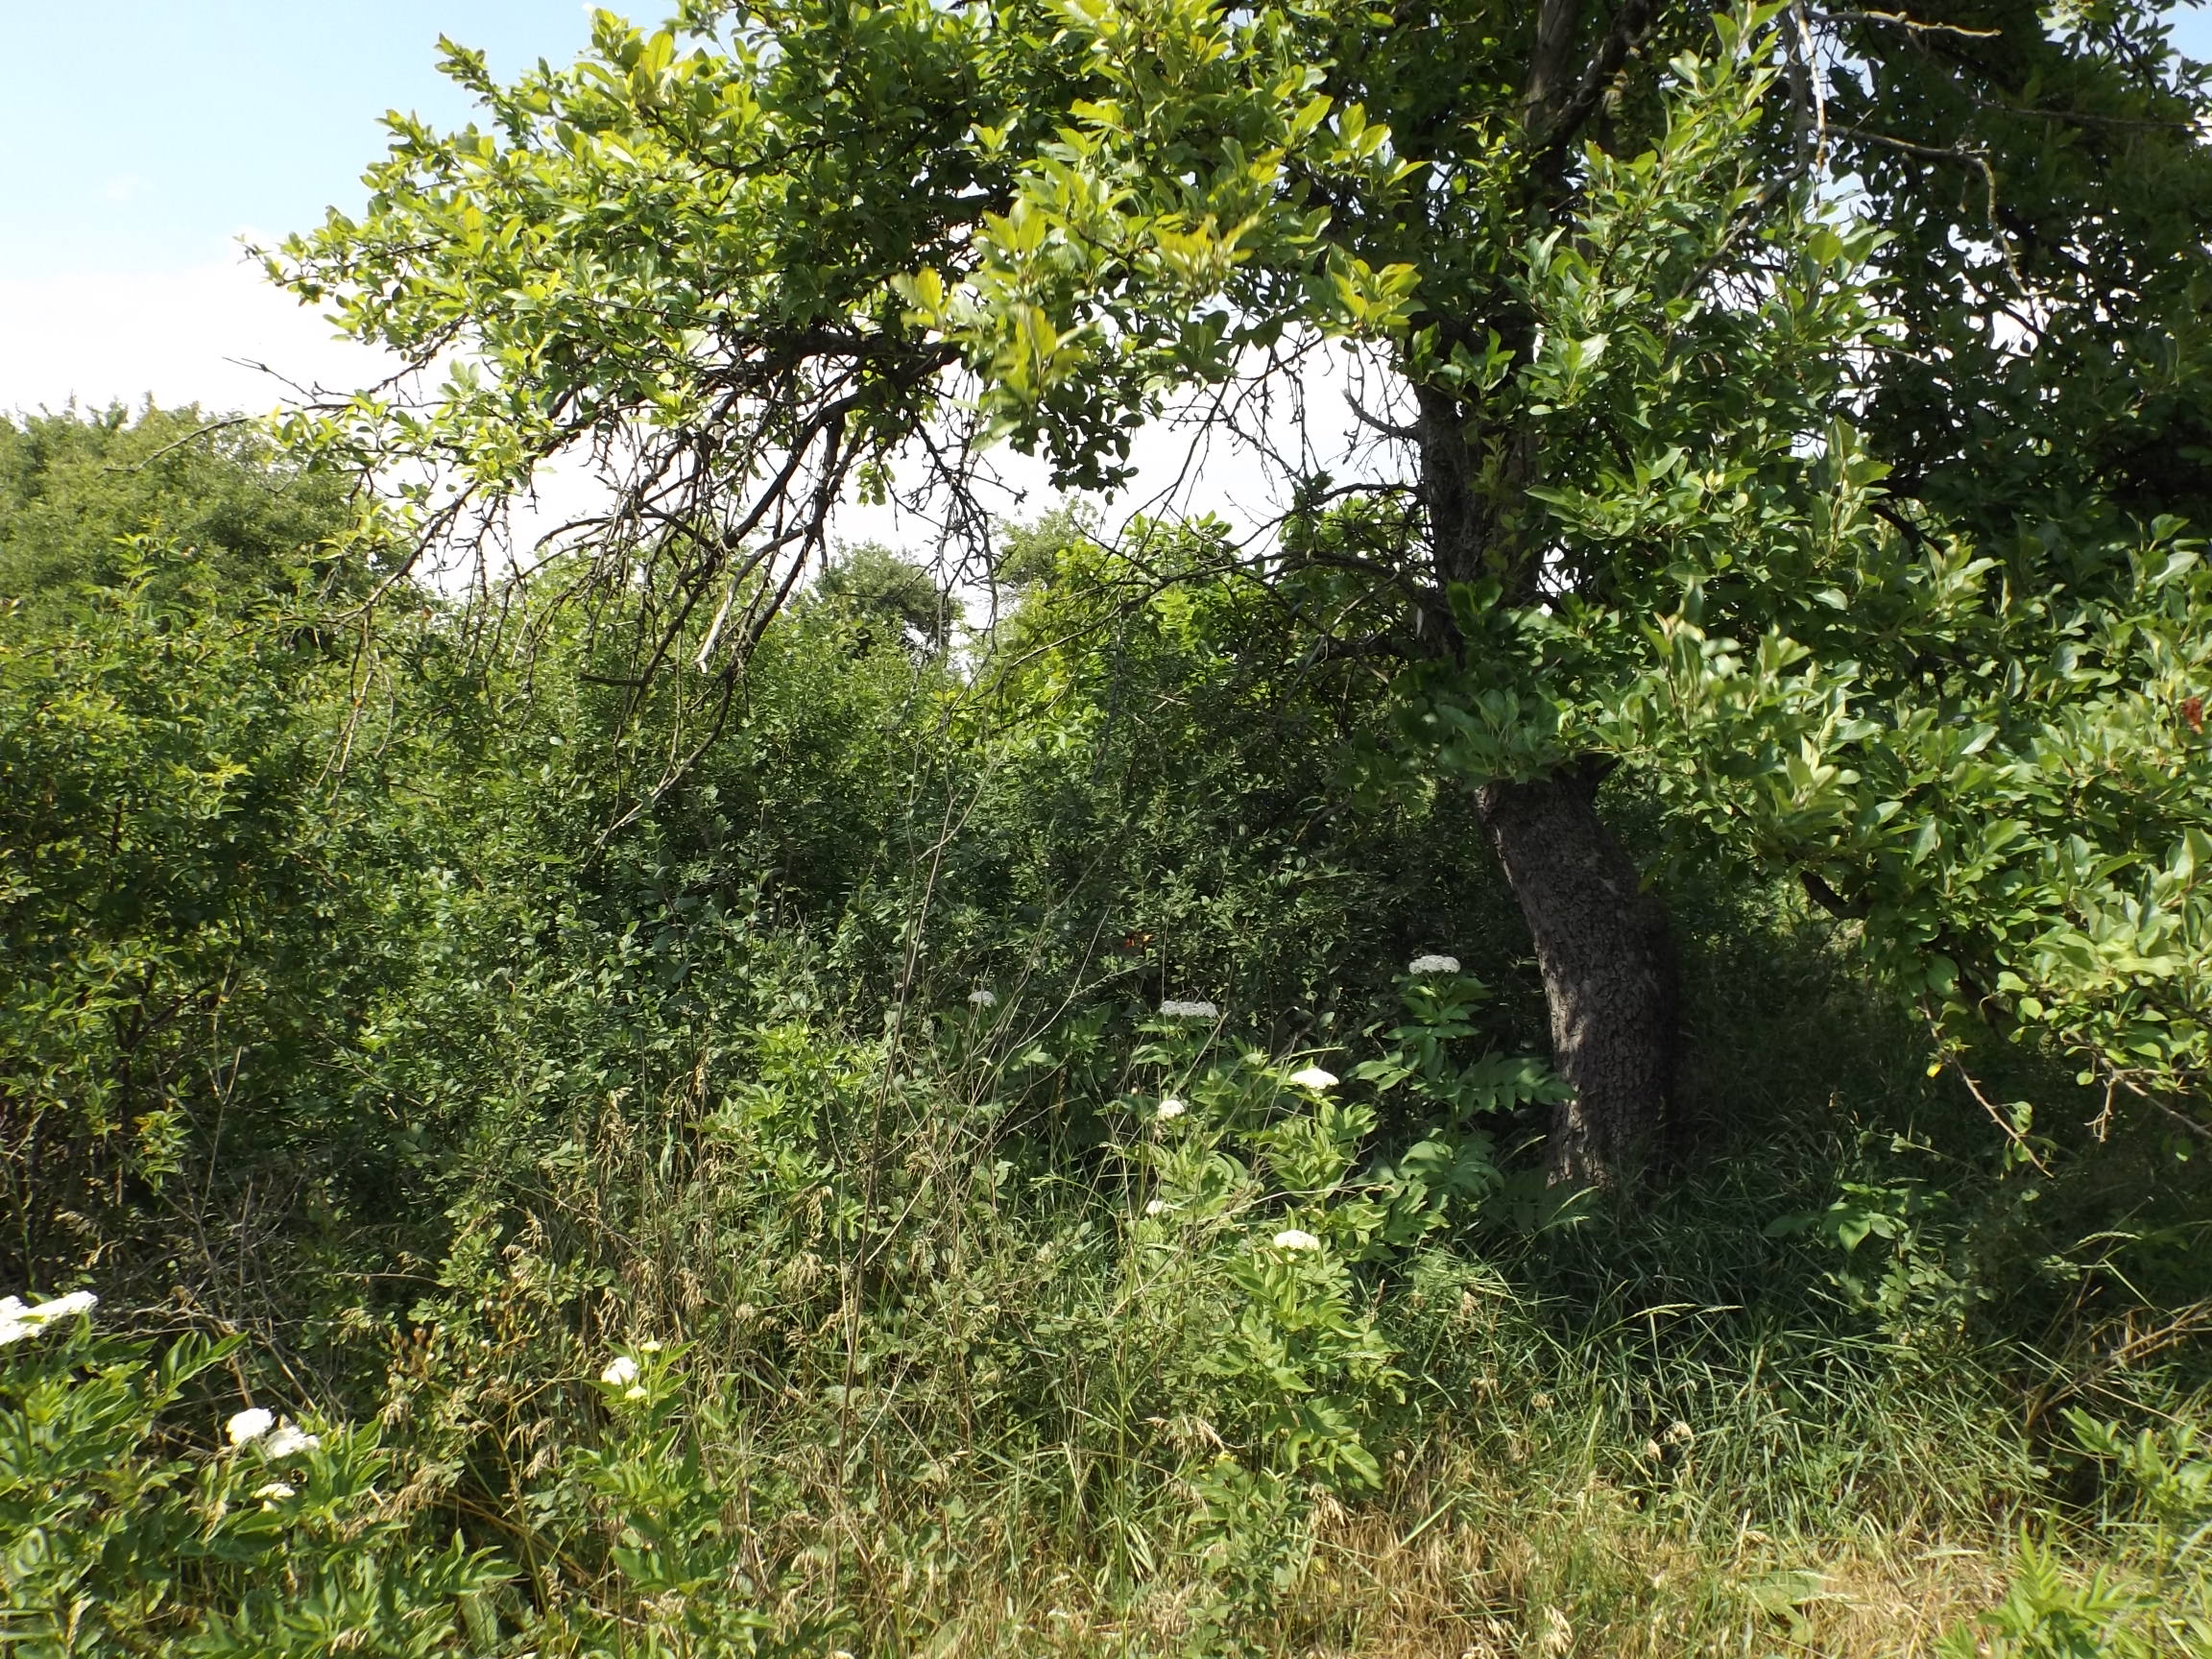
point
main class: Cropland
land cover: Apple fruit
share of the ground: 25 - 50 %
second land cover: Spontaneously vegetated surfaces
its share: > 75 %
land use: Agriculture (excluding fallow land and kitchen gardens)
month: June
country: BG
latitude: 43.5315
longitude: 27.3899
